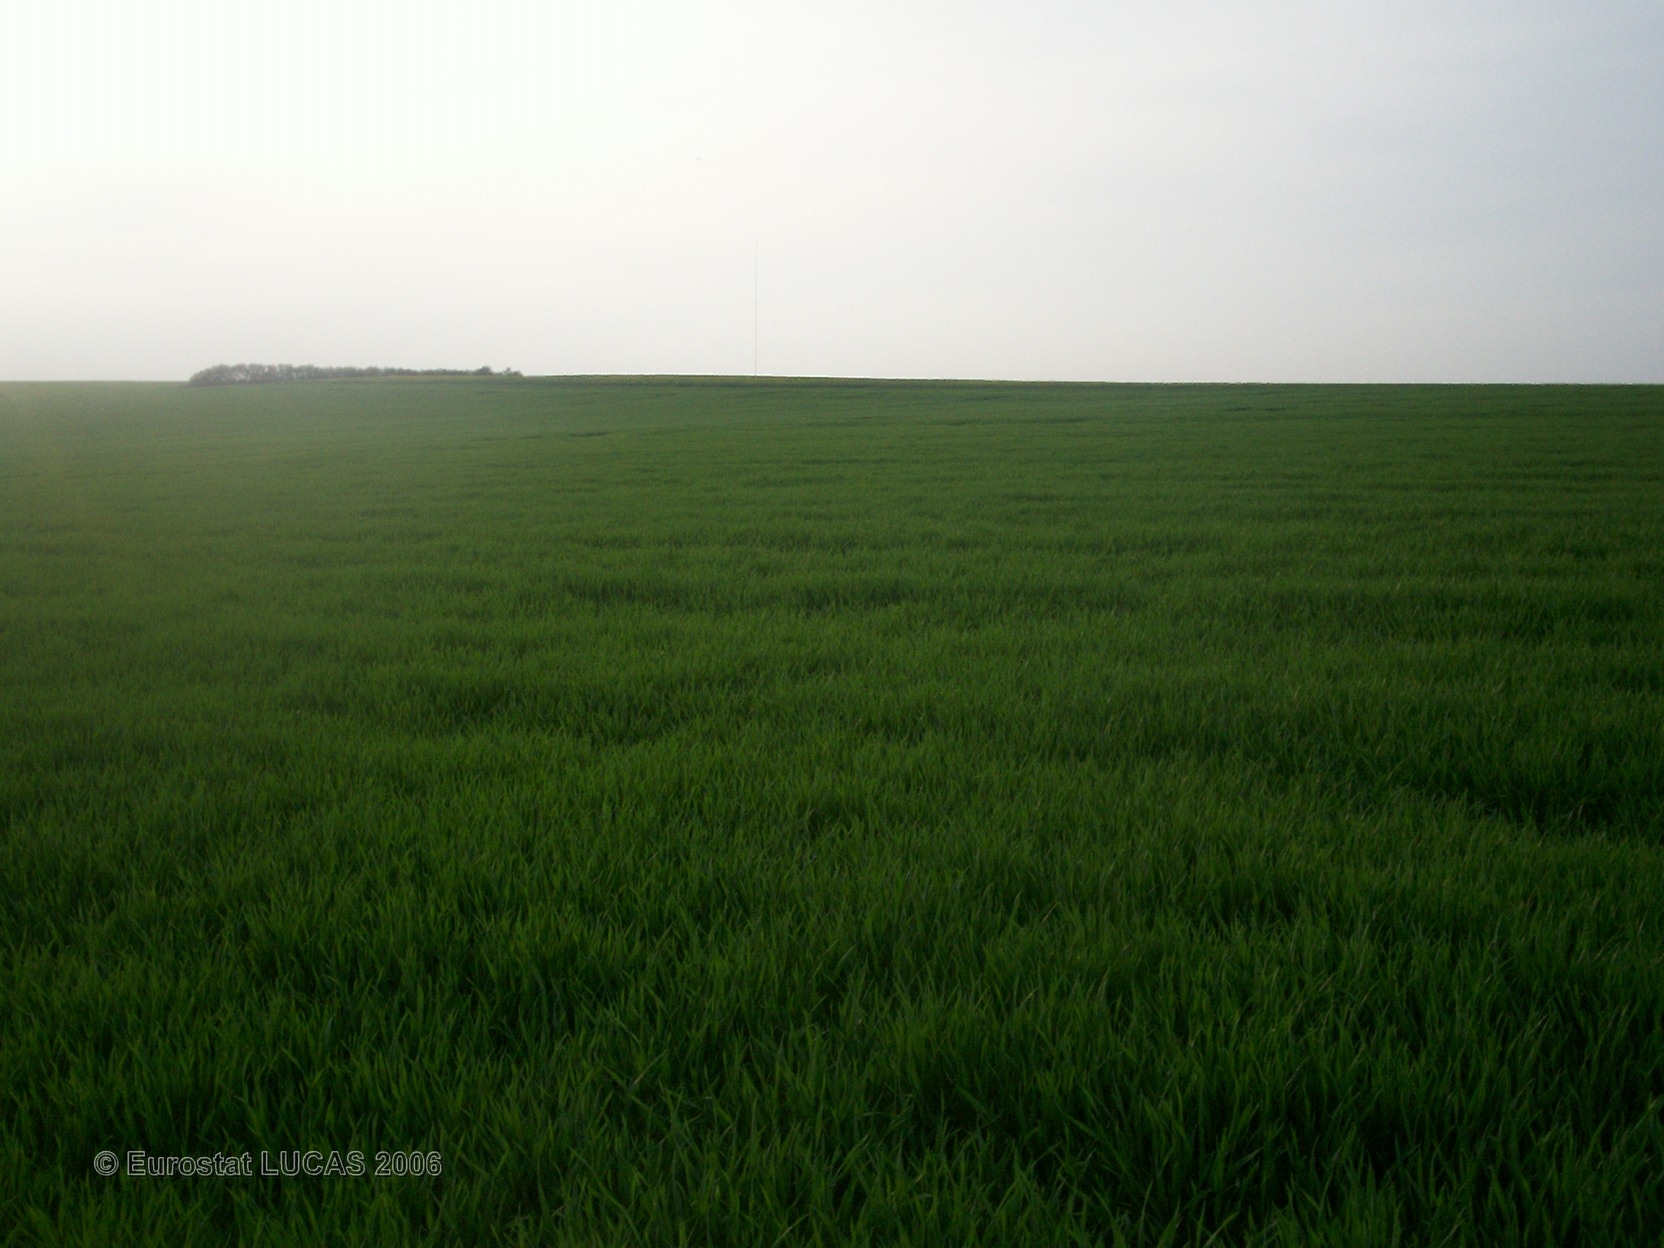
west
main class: Cropland
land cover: Common wheat
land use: Agriculture (excluding fallow land and kitchen gardens)
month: May
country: FR
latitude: 49.1362
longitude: 6.9712
